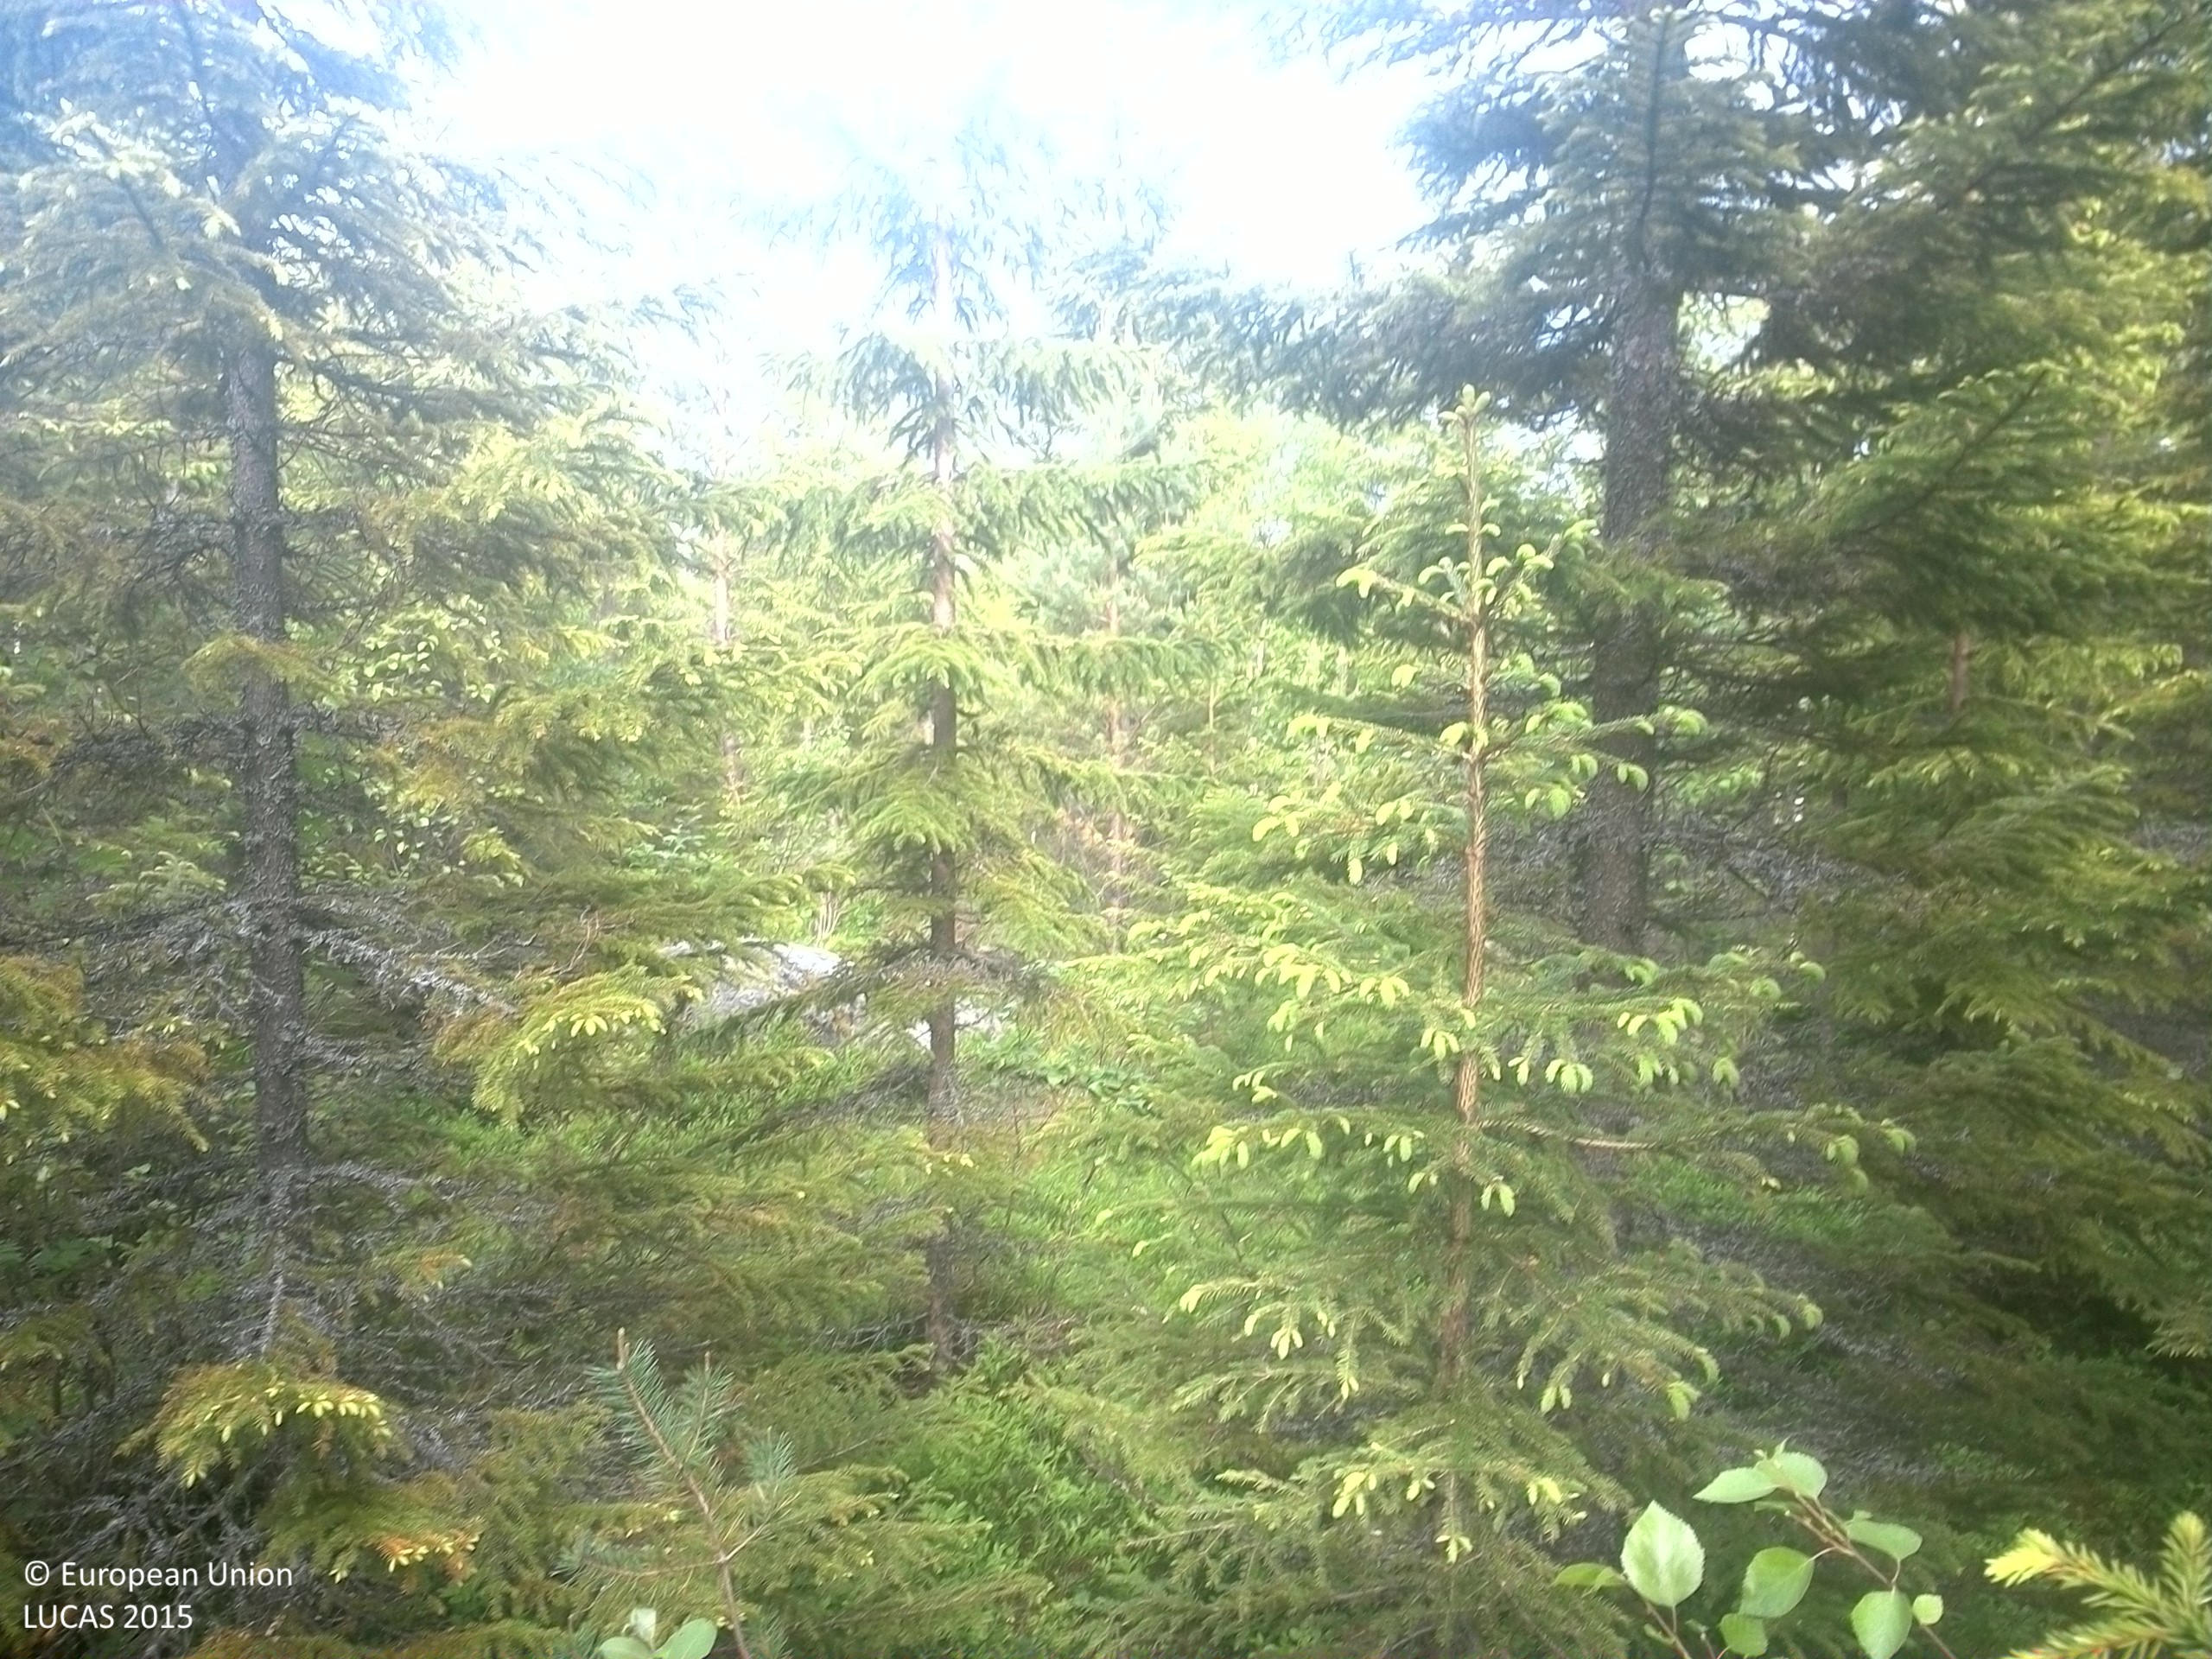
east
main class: Woodland
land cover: Spruce dominated mixed woodland
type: boreal forest
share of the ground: > 75 %
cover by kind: coniferous forest trees 55 %, shrubs 25 %, broadleaved forest trees 20 %
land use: Forestry
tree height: > 5 m
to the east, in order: Spruce dominated mixed woodland; Broadleaved woodland
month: June
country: SE
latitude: 63.4611
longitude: 17.8183
